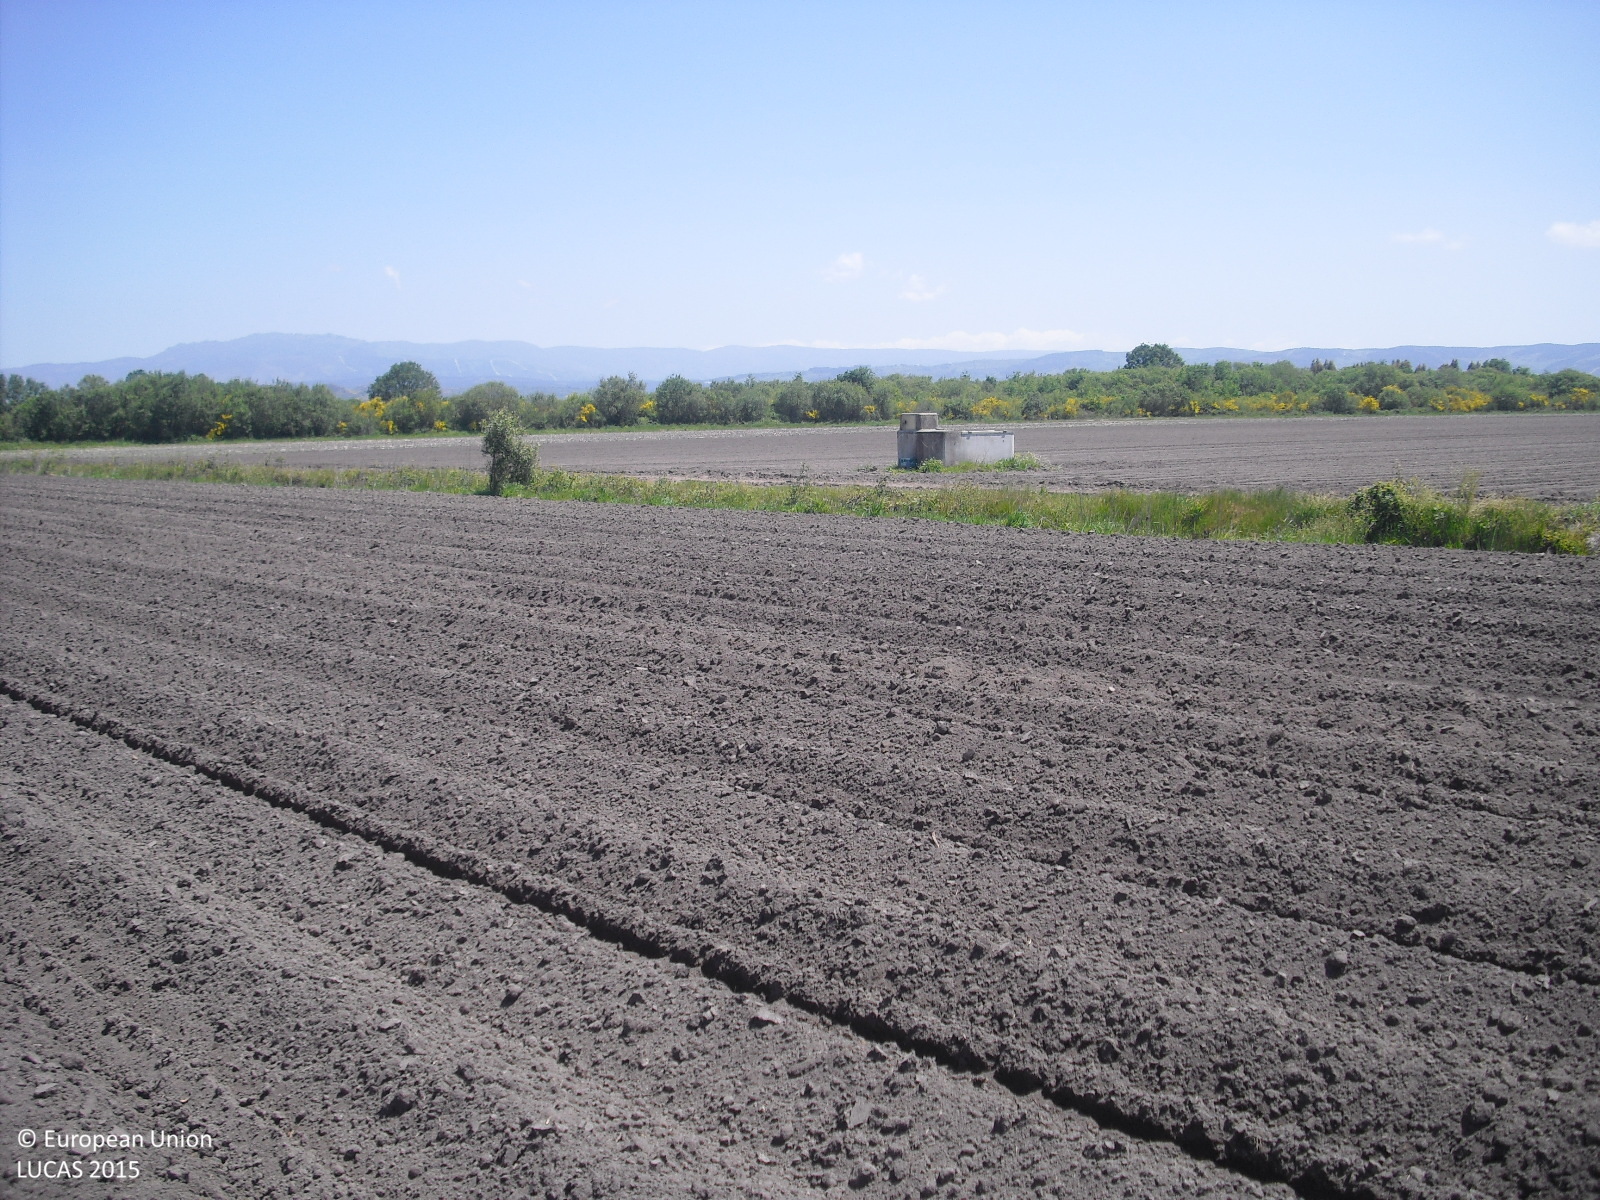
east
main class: Cropland
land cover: Potatoes
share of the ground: < 10 %
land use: Agriculture (excluding fallow land and kitchen gardens)
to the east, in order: Potatoes; Grass margins; Ditches and canals; Grass margins; Tracks; Potatoes; Artificial constructions in urban areas; Potatoes; Other bare soil; Grass margins; Tracks; Shruby margins; Ditches and canals; Shrubland without tree cover; Shrubland with sparse tree cover
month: May
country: ES
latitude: 42.1500
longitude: -7.7015
